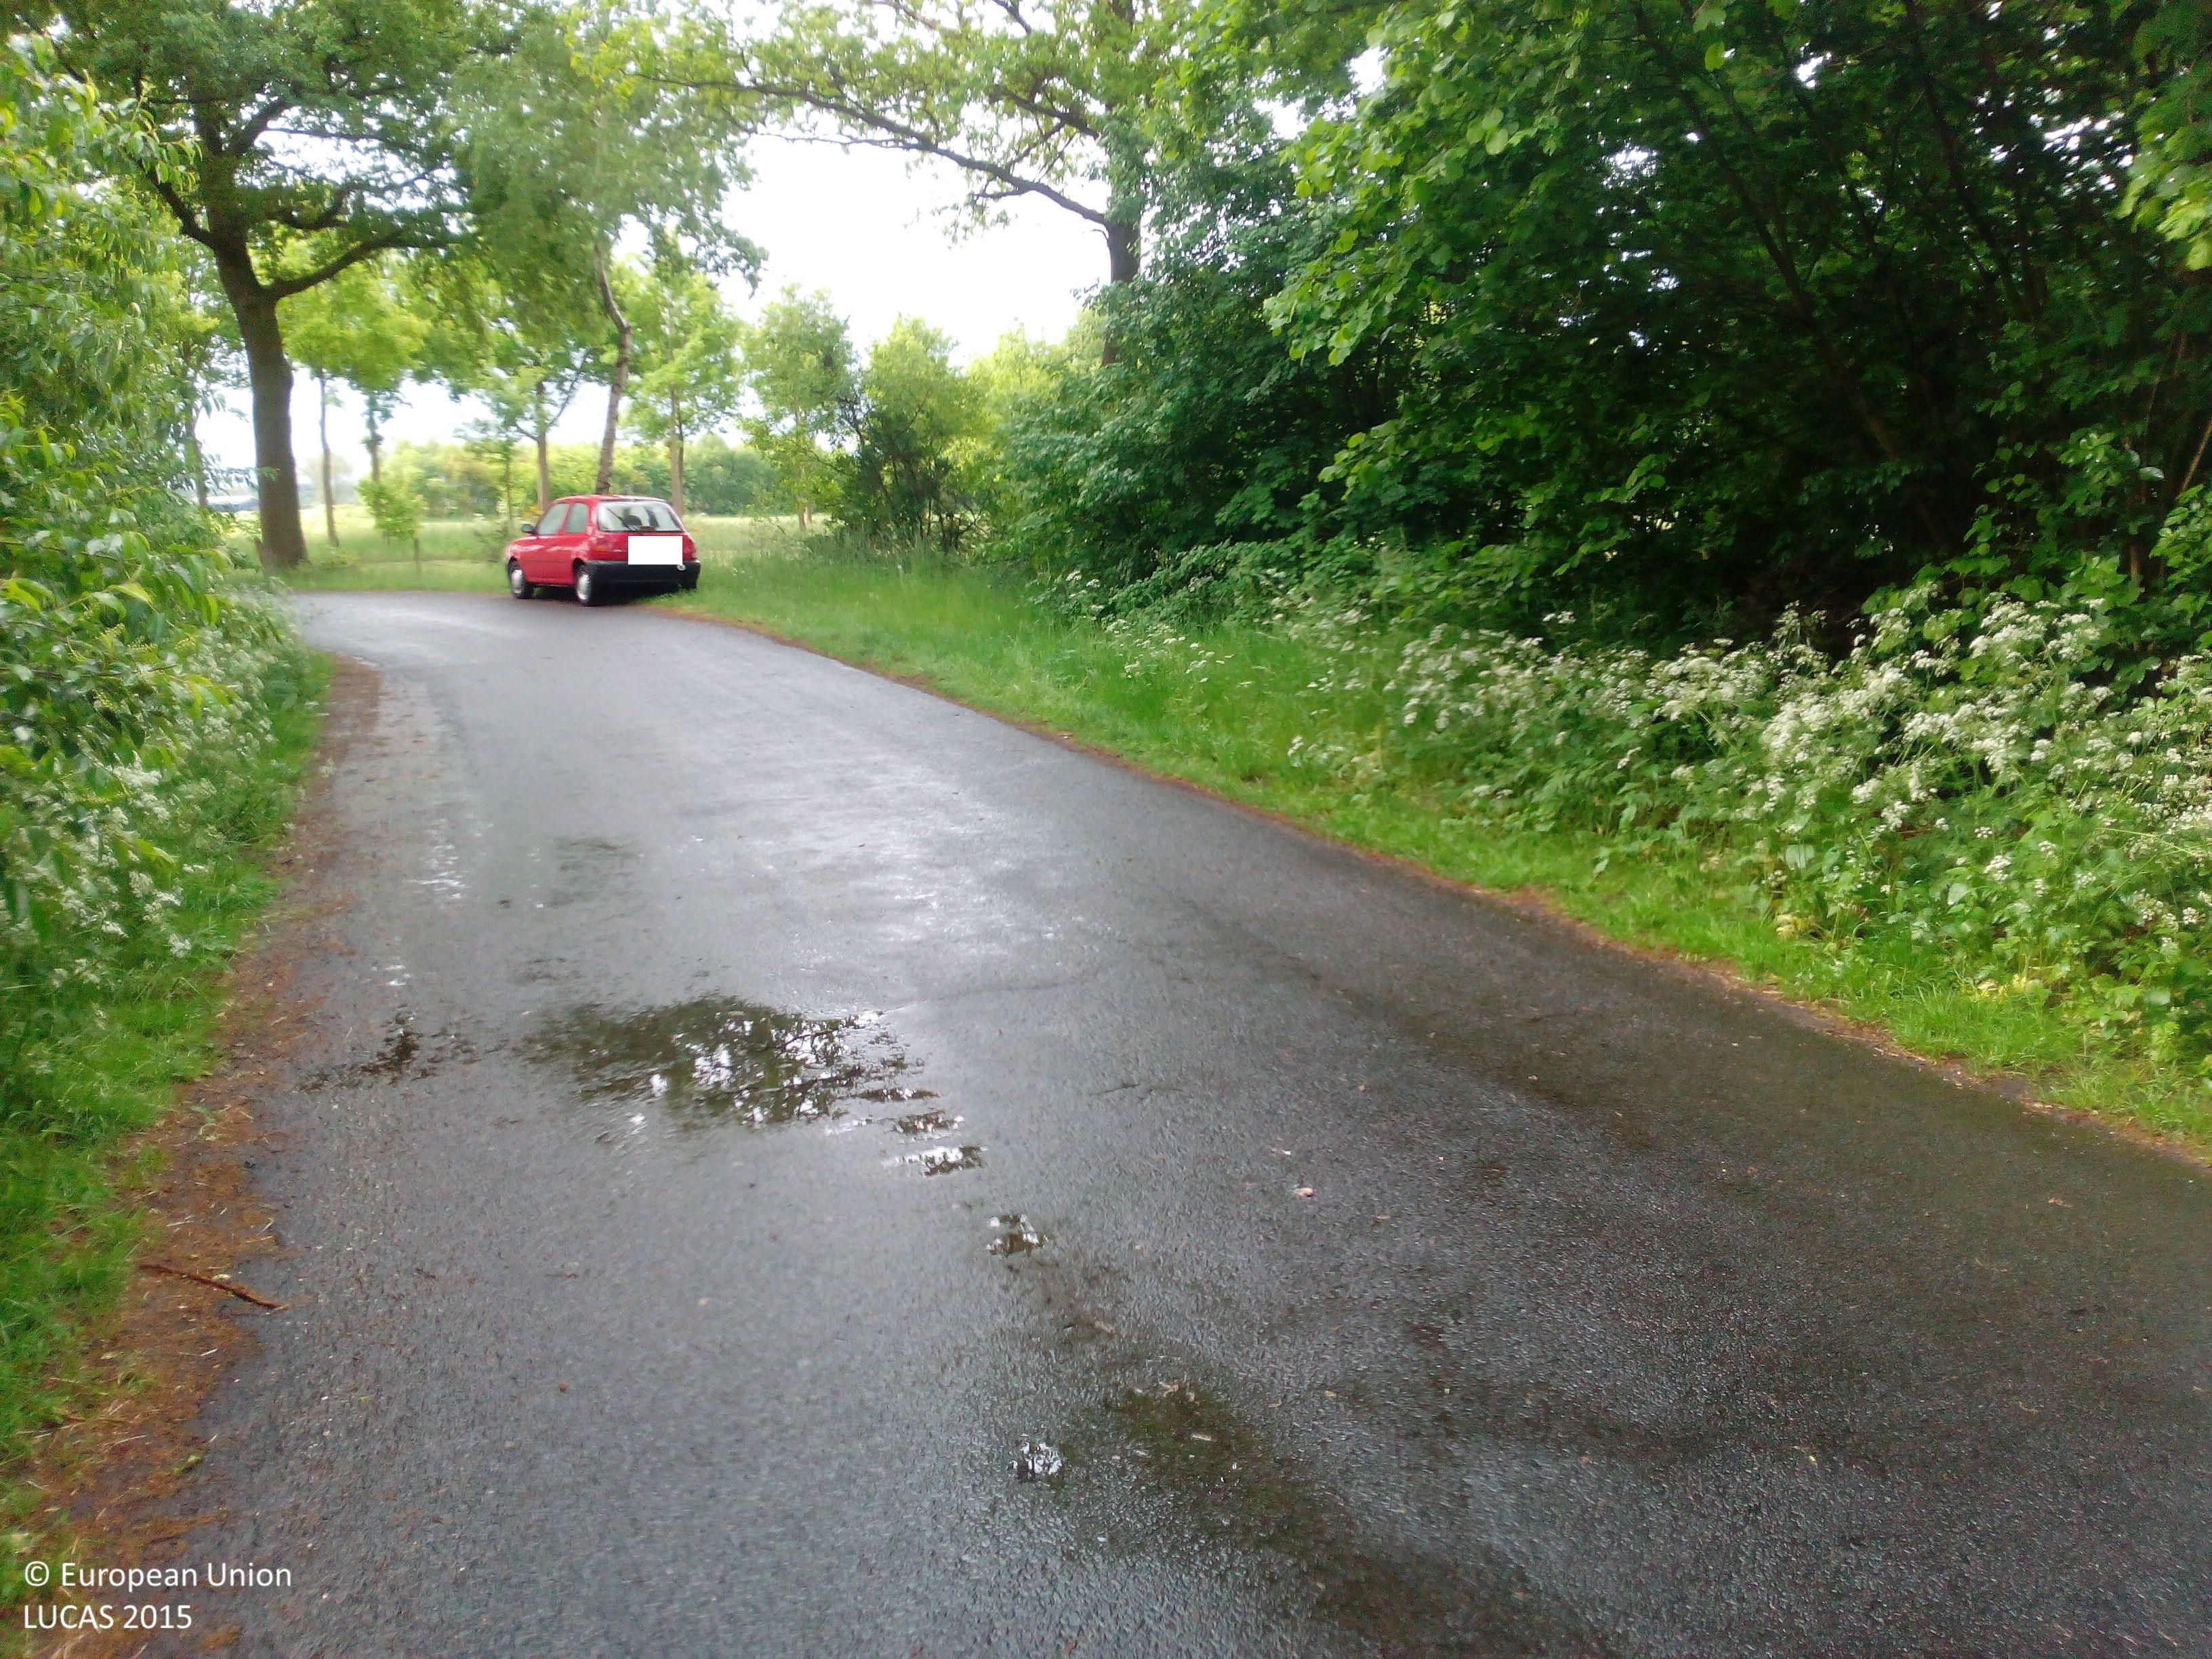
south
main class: Woodland
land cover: Broadleaved woodland
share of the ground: > 75 %
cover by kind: broadleaved forest trees 90 %, shrubs 10 %
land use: Road transport
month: May
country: NL
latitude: 52.2827
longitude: 6.2616
